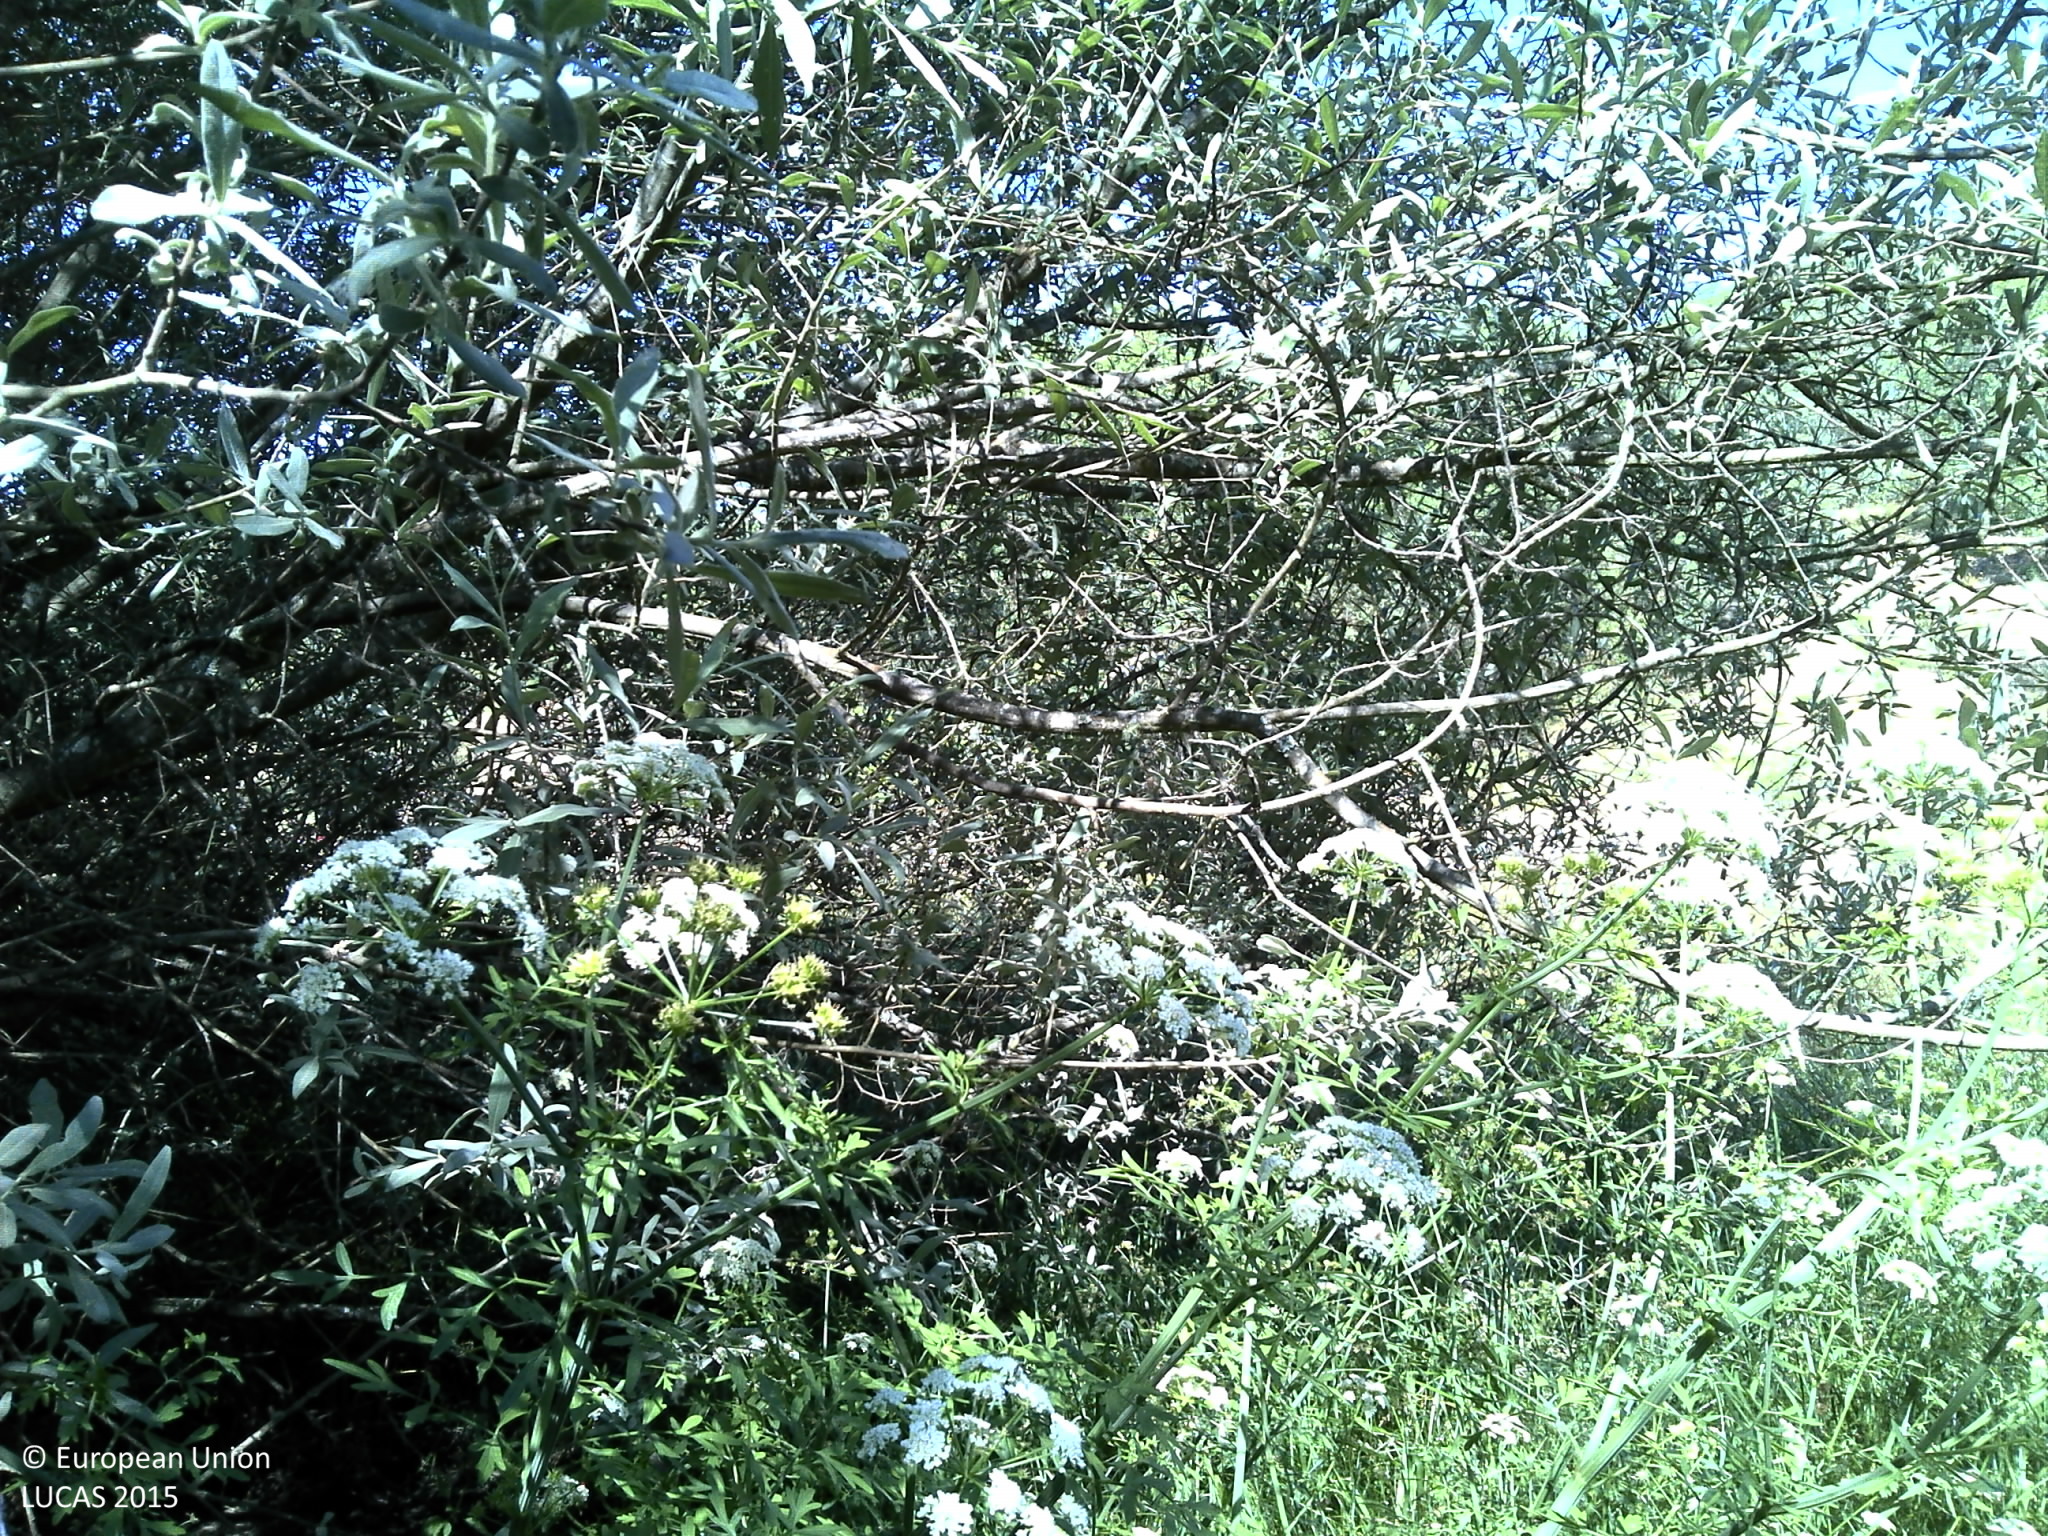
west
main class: Shrubland
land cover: Shrubland with sparse tree cover
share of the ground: > 75 %
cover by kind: shrubs 95 %, broadleaved forest trees 5 %
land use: Semi-natural and natural areas not in use
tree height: > 5 m
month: May
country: PT
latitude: 38.8886
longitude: -8.1634
